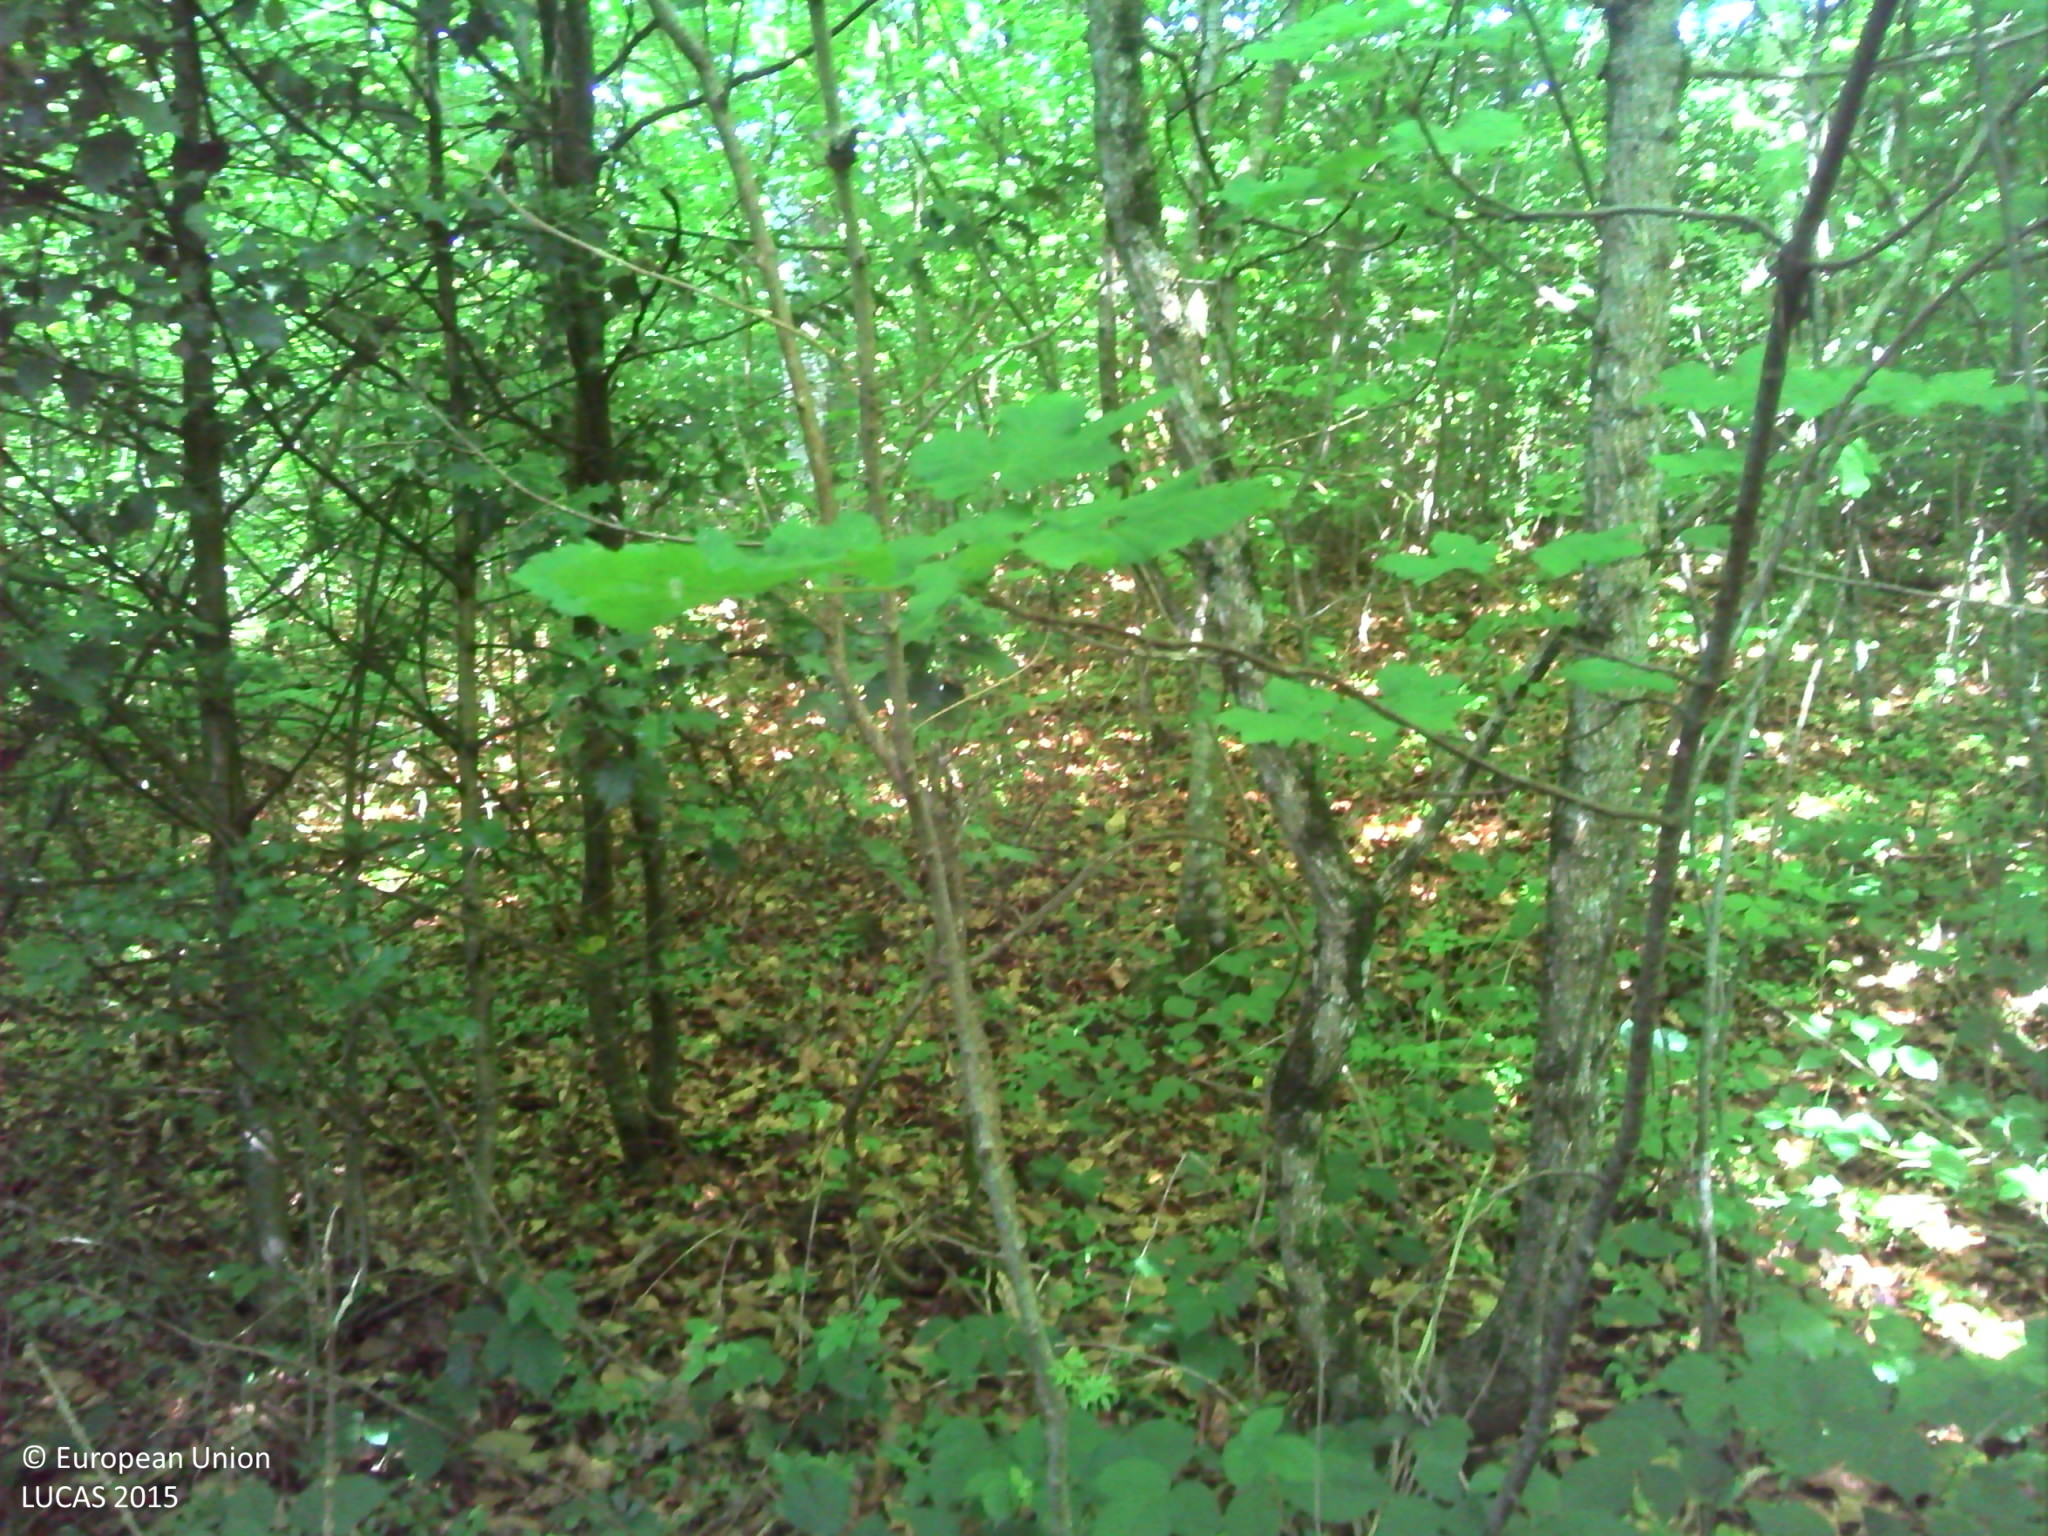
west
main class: Woodland
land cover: Broadleaved woodland
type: beech forest
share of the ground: > 75 %
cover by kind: broadleaved forest trees 90 %, shrubs 5 %, herbaceous plants 5 %
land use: Forestry
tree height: > 5 m
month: June
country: FR
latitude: 46.4701
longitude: 5.4315
